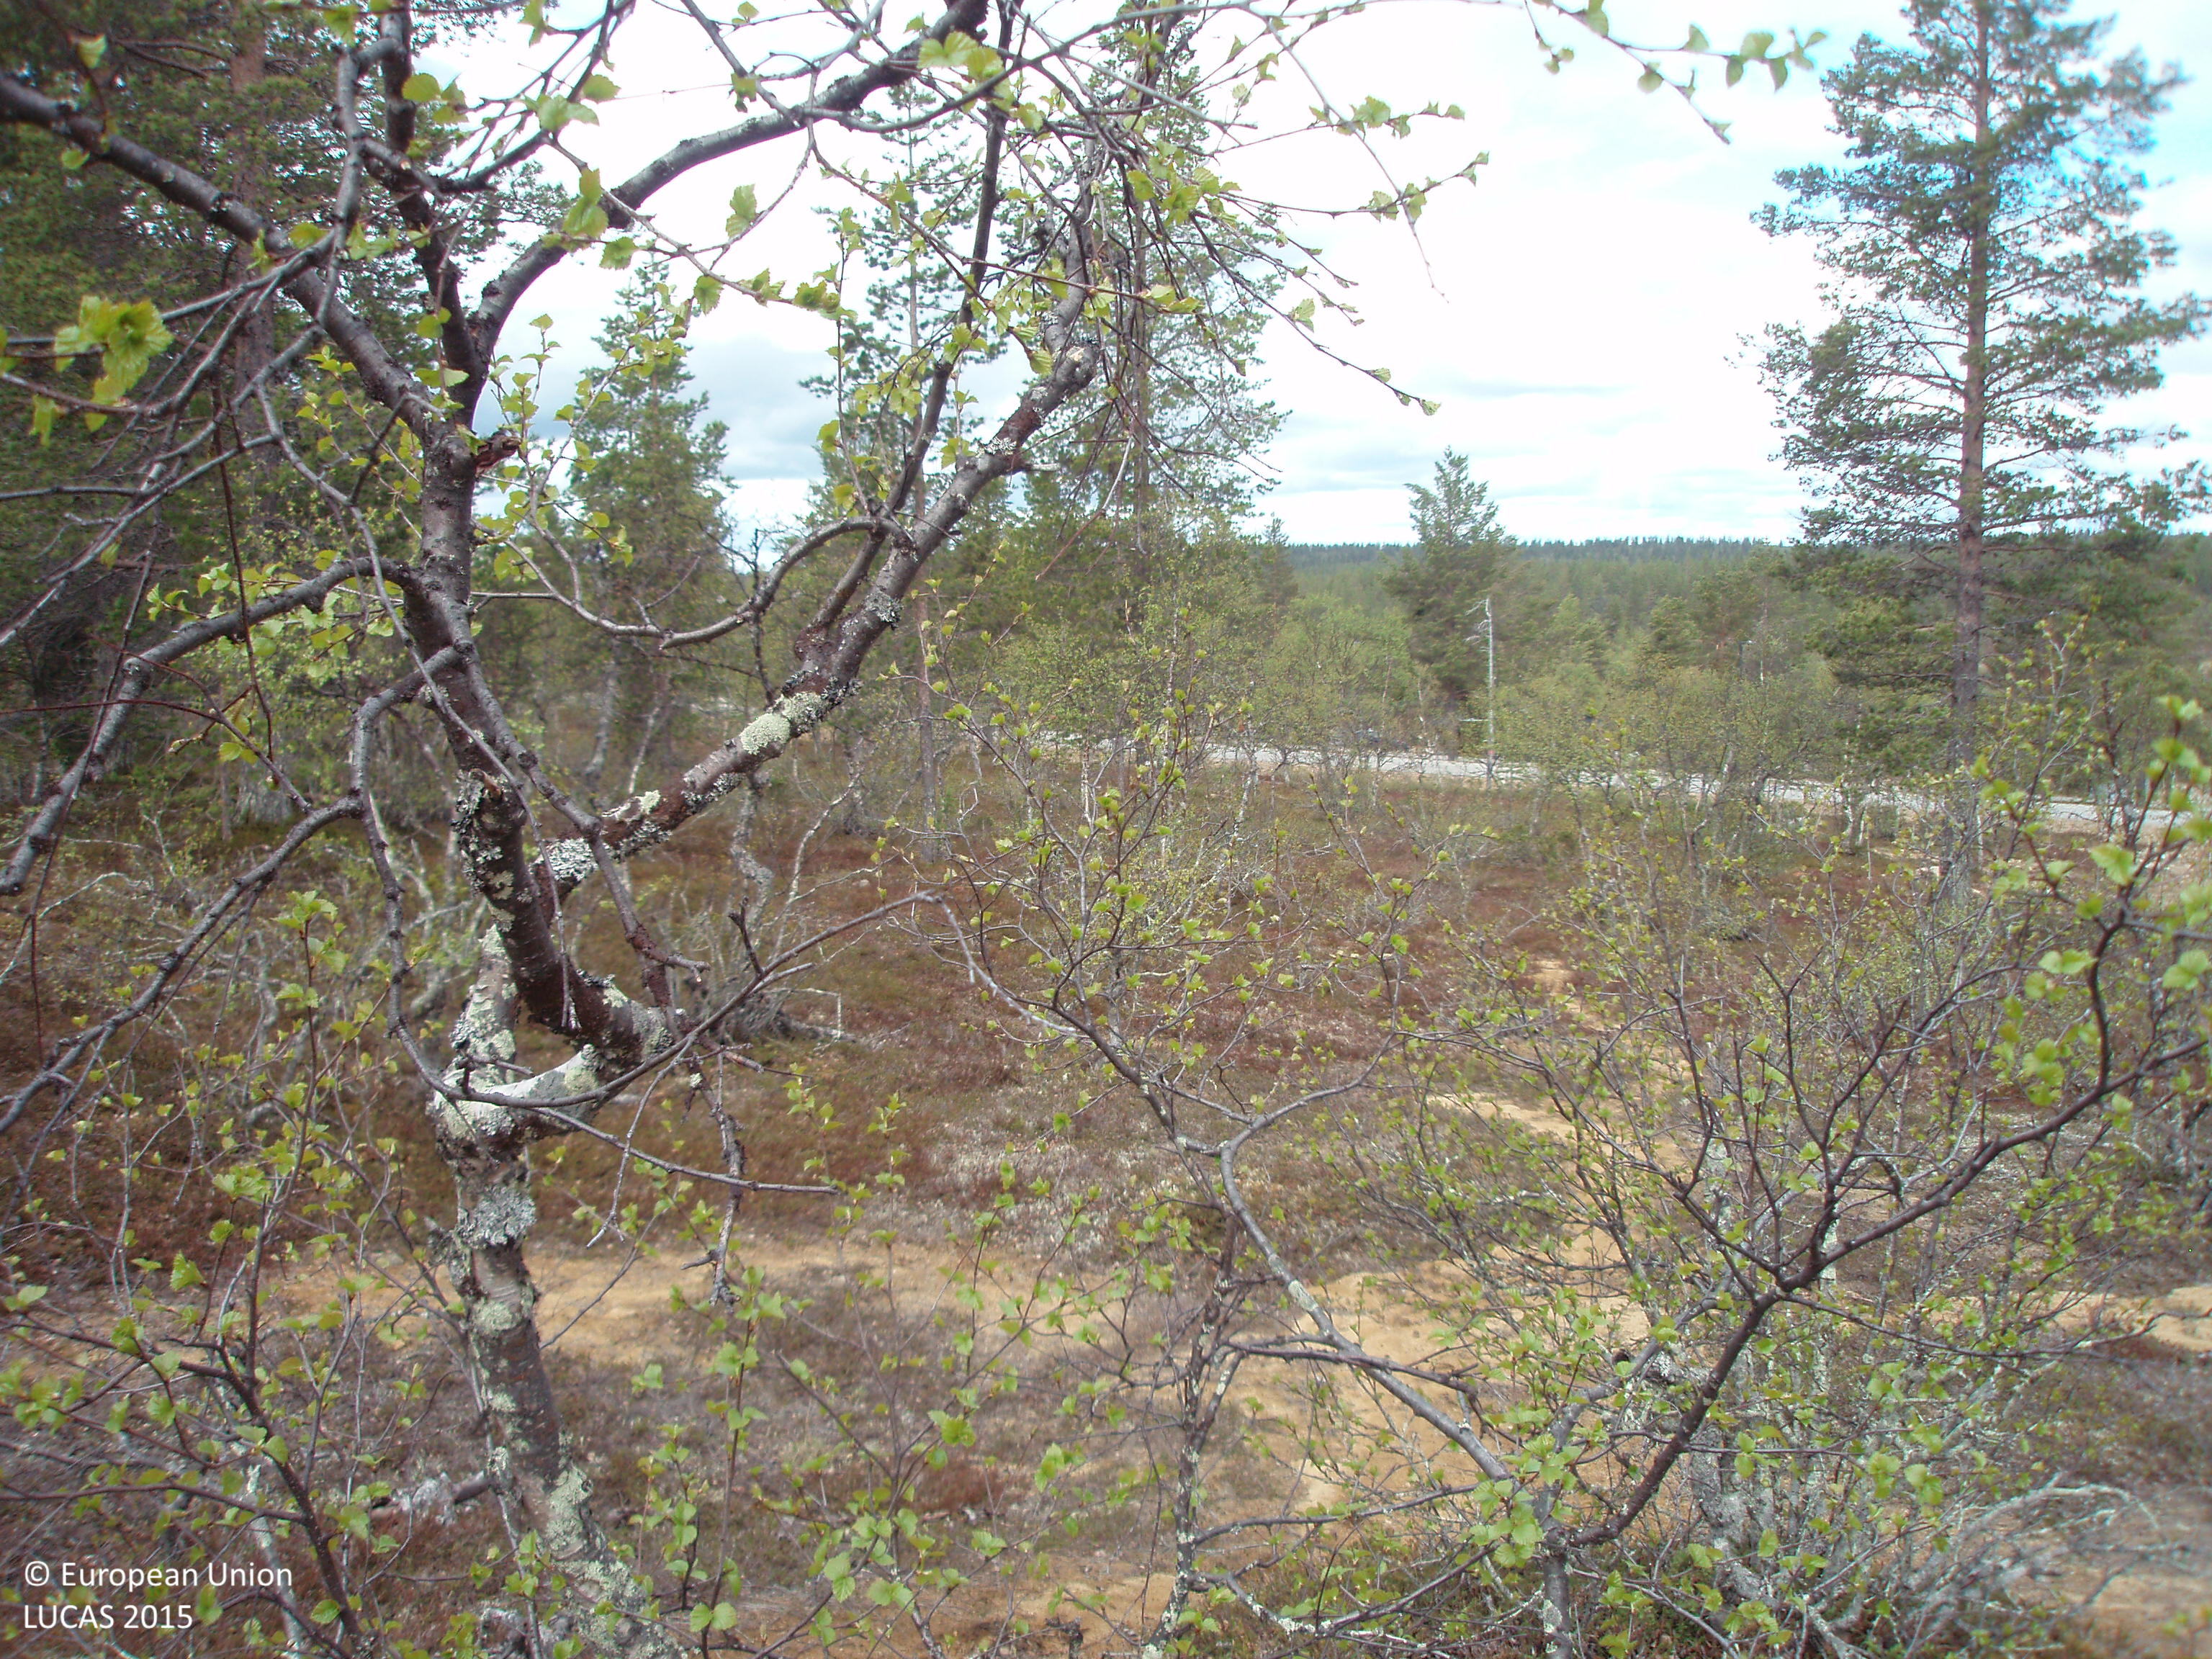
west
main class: Woodland
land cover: Other mixed woodland
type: boreal forest
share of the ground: > 75 %
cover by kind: broadleaved forest trees 55 %, shrubs 25 %, coniferous forest trees 20 %
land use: Amenities, museums, leisure
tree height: > 5 m
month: June
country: FI
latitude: 68.2093
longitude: 27.6880
